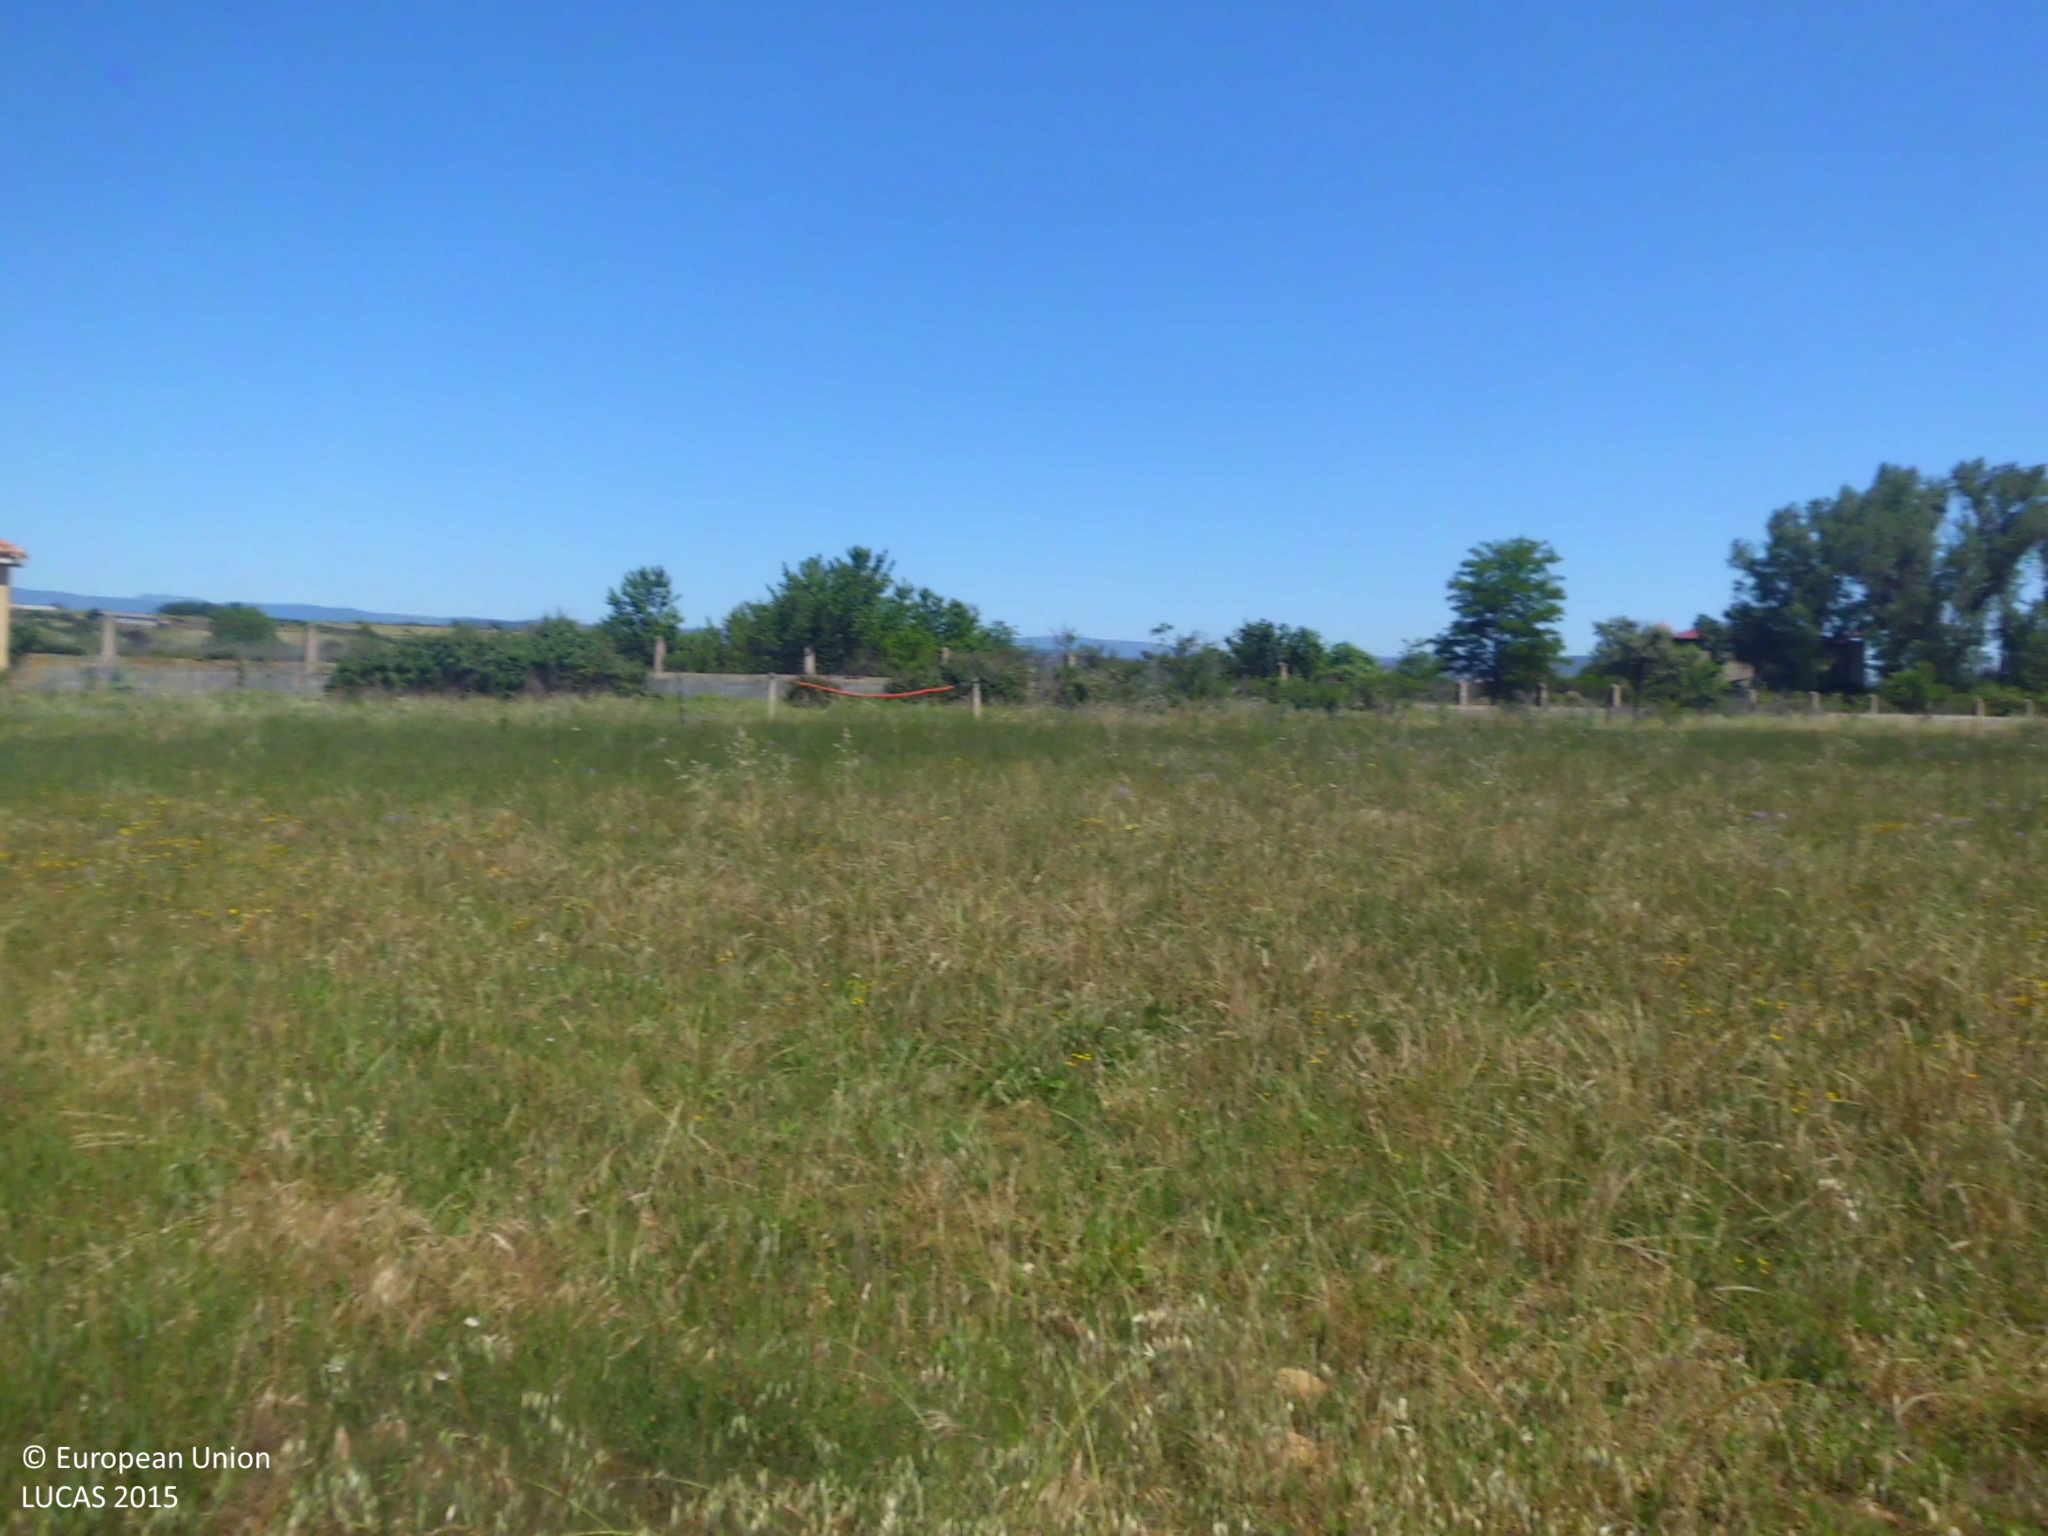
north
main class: Grassland
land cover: Grassland without tree/shrub cover
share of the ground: > 75 %
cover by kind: herbaceous plants 100 %
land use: Agriculture (excluding fallow land and kitchen gardens)
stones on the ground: 25 - 50 %
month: June
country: ES
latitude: 42.9153
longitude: -3.5018
